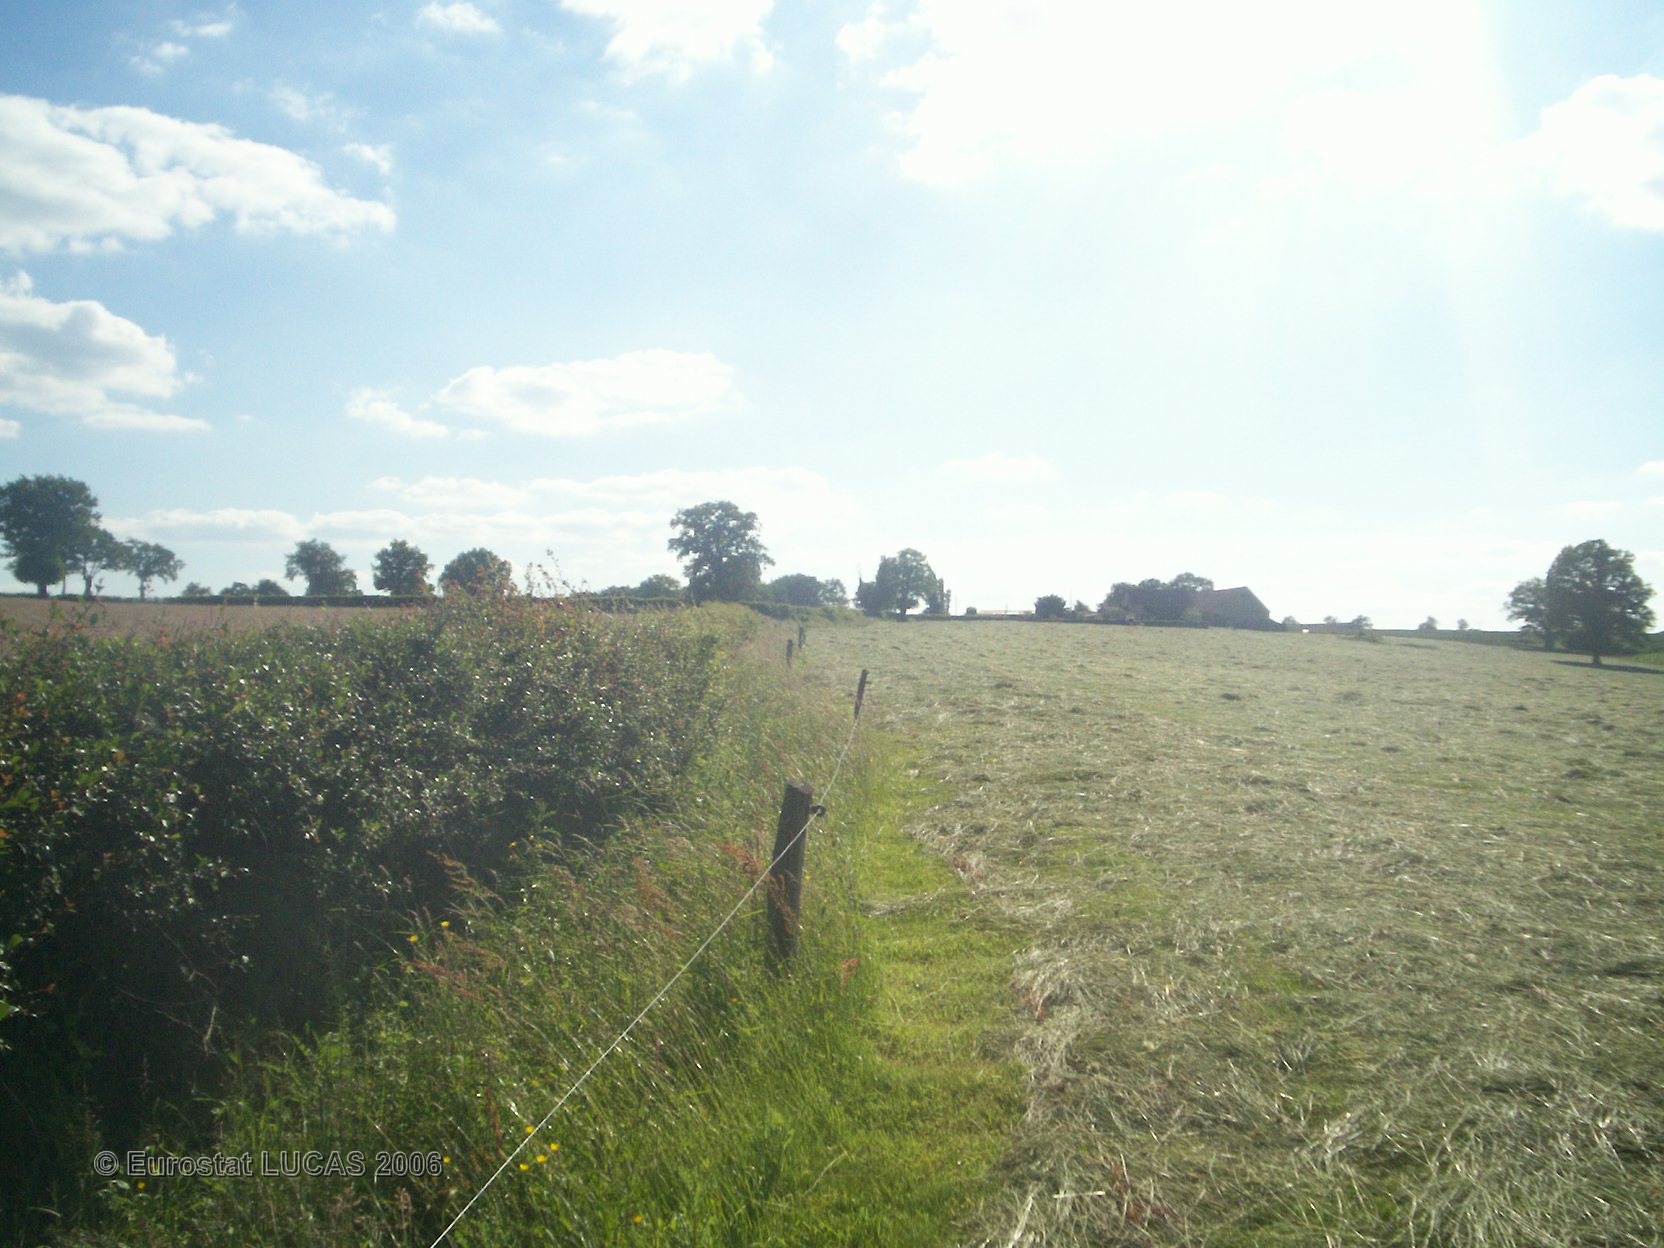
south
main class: Grassland
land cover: Grassland without tree/shrub cover
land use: Agriculture (excluding fallow land and kitchen gardens)
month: June
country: FR
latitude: 46.3126
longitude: 3.1548
